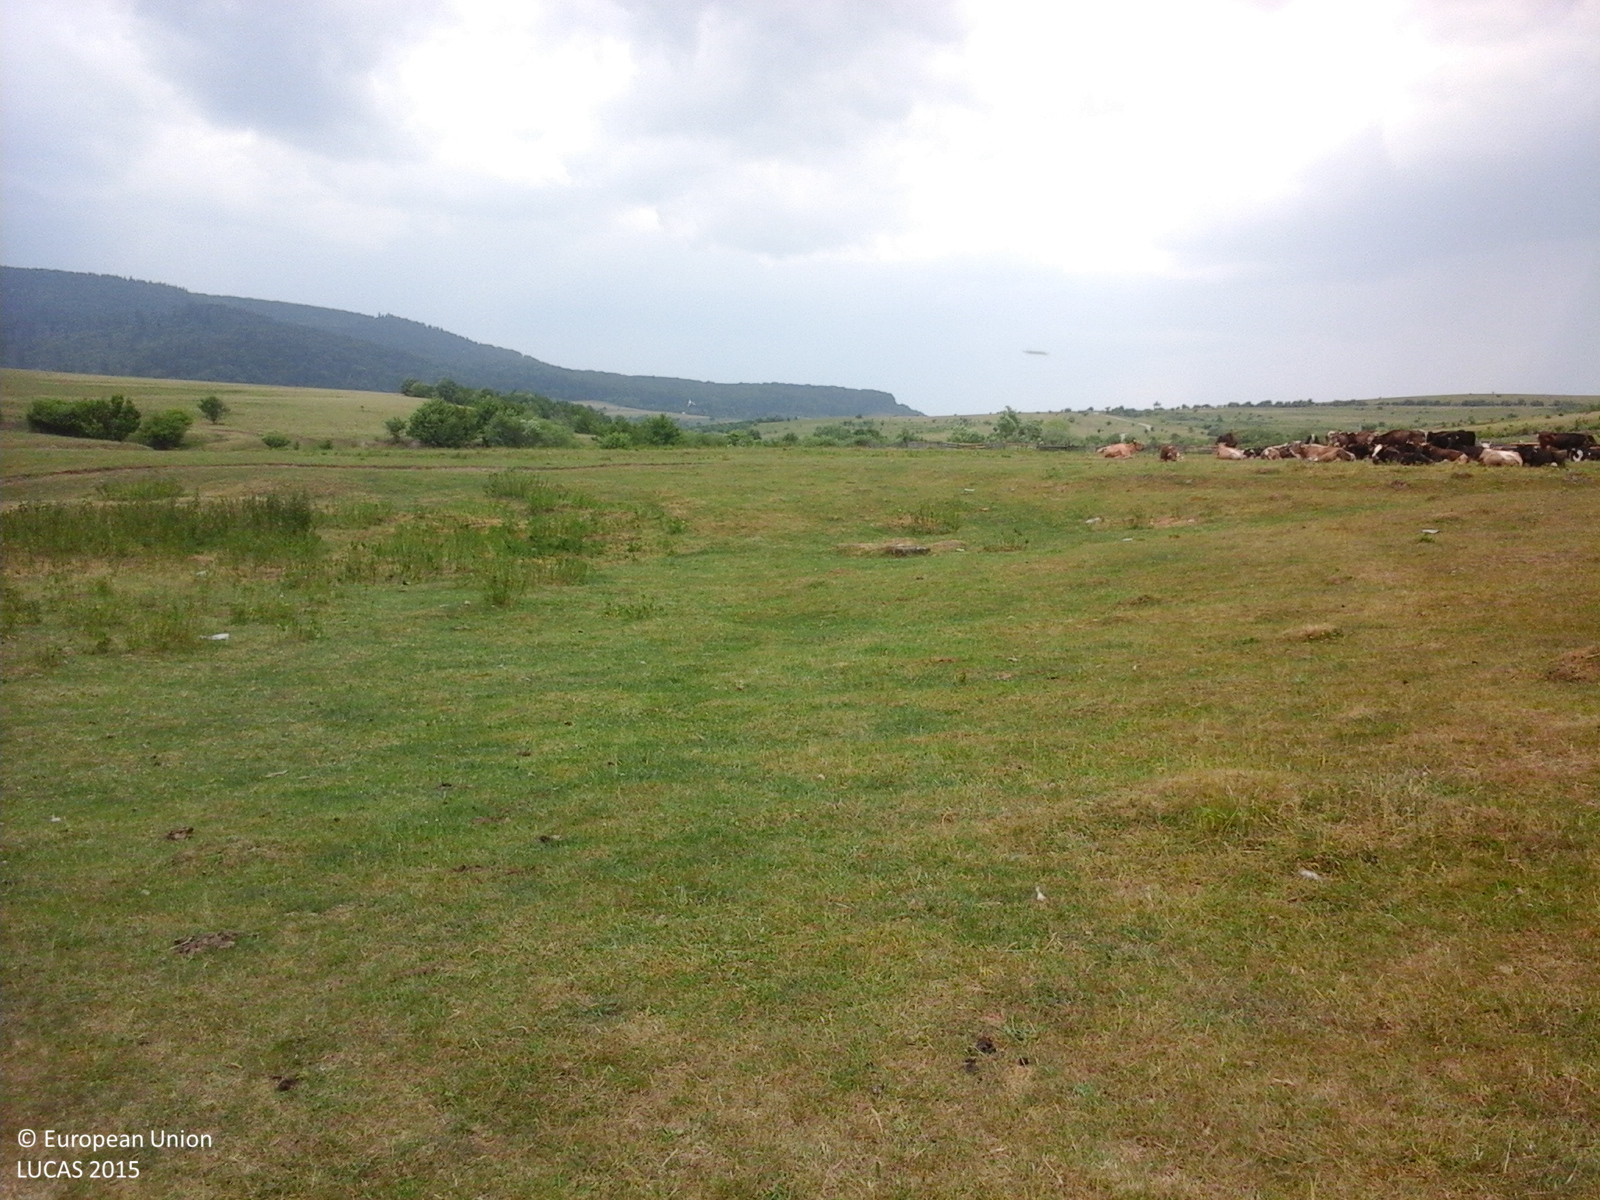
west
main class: Grassland
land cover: Grassland without tree/shrub cover
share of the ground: > 75 %
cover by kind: herbaceous plants 100 %
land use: Agriculture (excluding fallow land and kitchen gardens)
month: June
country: RO
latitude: 47.2046
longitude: 26.2792
